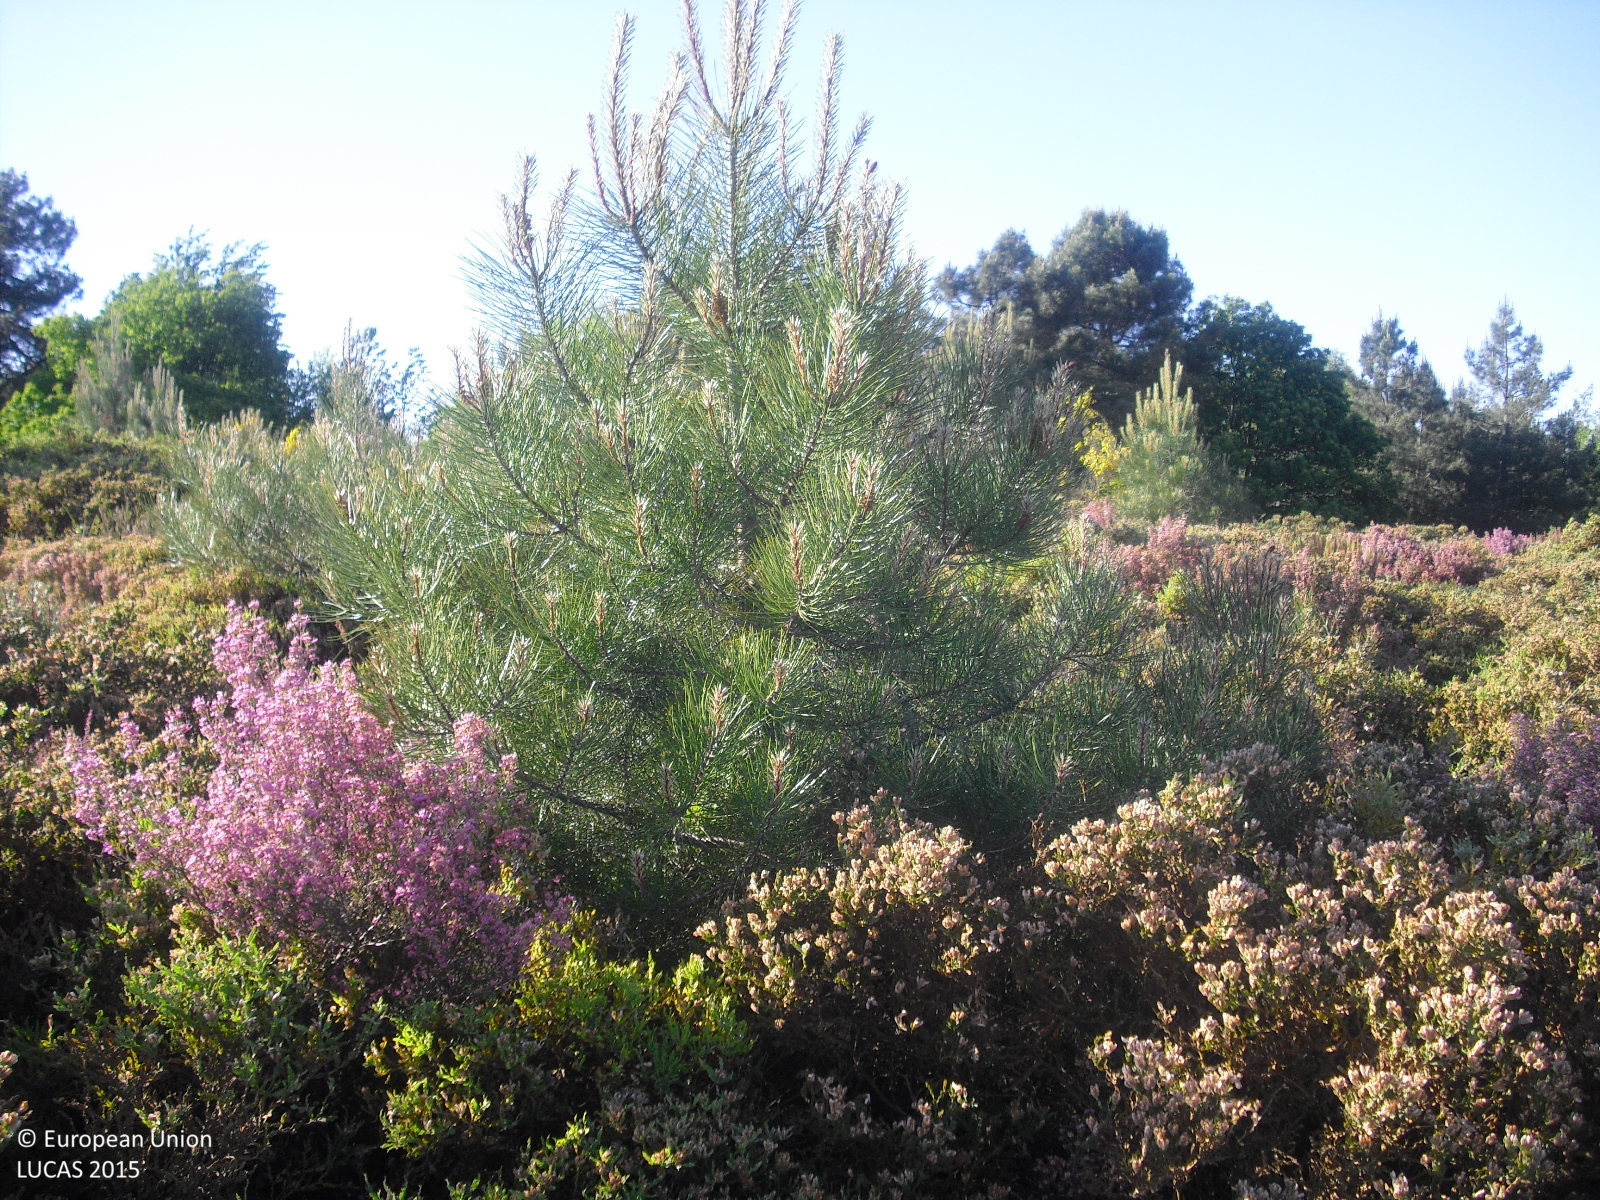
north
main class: Shrubland
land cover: Shrubland with sparse tree cover
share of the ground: > 75 %
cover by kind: shrubs 95 %, coniferous forest trees 5 %
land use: Forestry
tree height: < 5 m
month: May
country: ES
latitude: 42.0383
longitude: -7.3950
